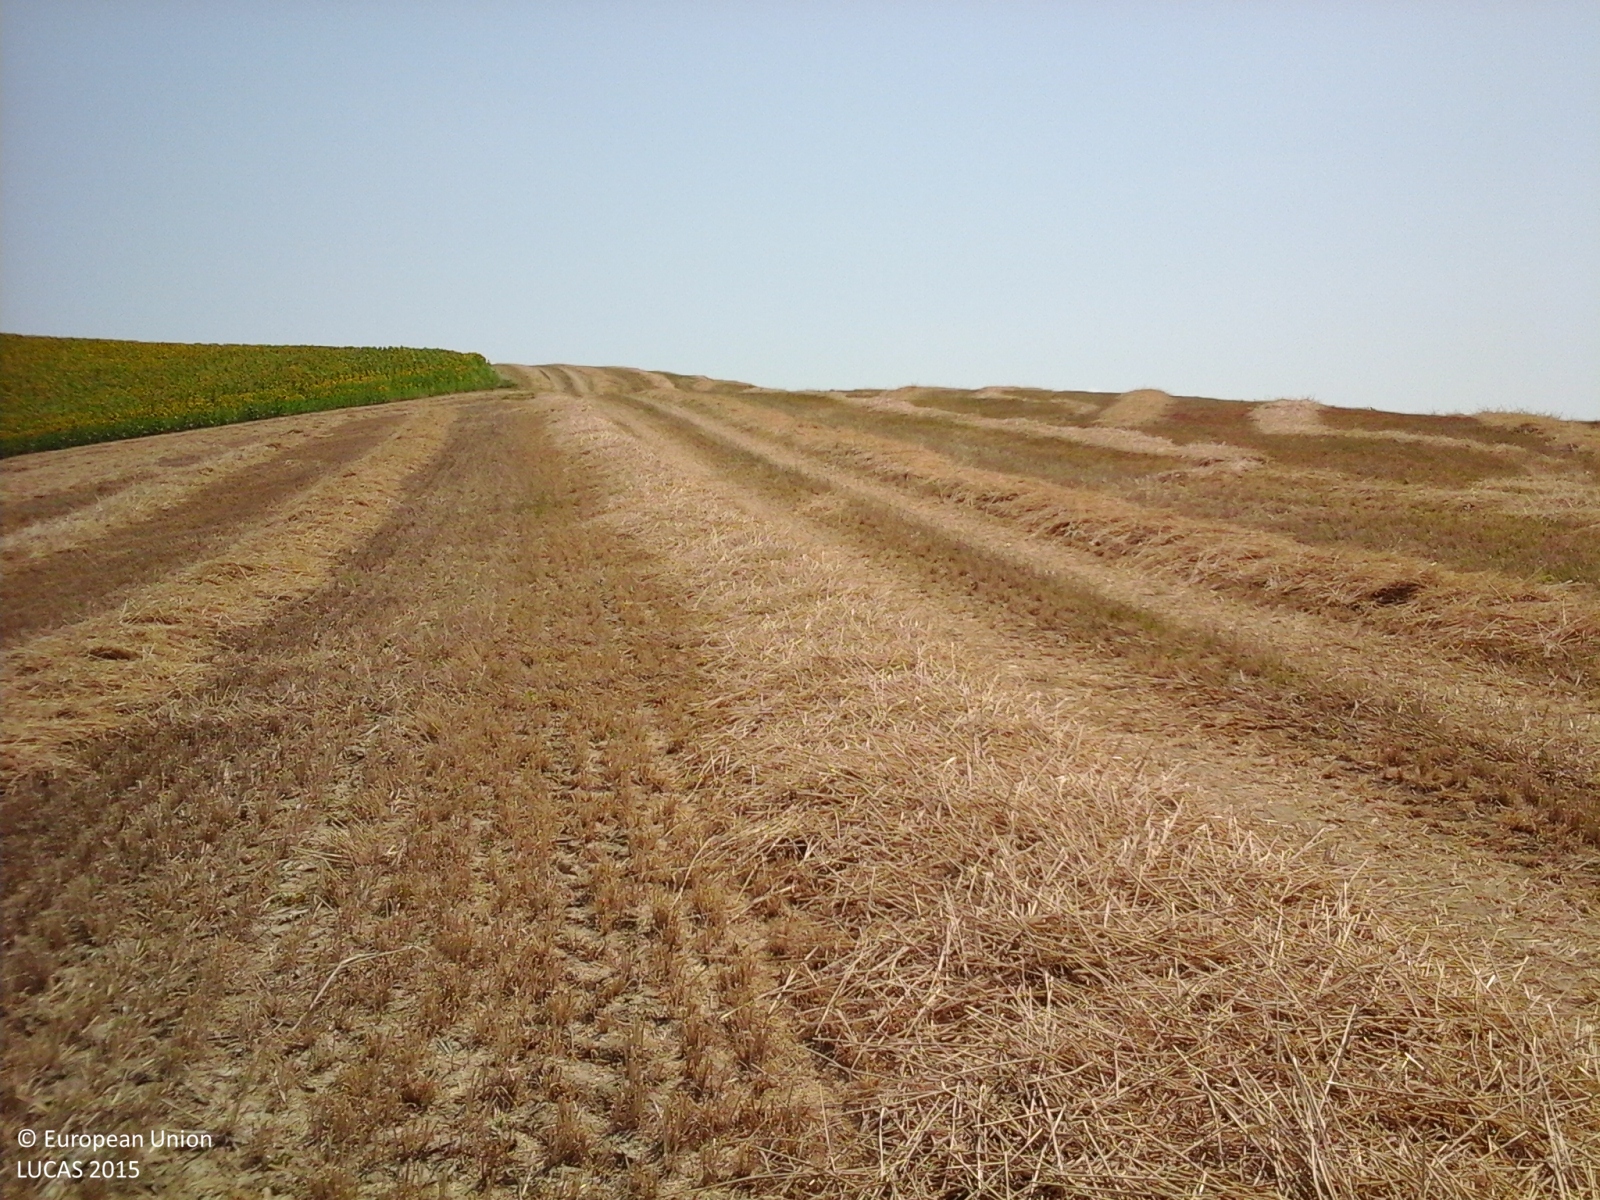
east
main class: Cropland
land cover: Durum wheat
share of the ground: > 75 %
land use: Agriculture (excluding fallow land and kitchen gardens)
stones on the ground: < 10 %
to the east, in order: Durum wheat; Tracks; Spontaneously vegetated surfaces; Broadleaved woodland; Electric lines; Broadleaved woodland
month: July
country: IT
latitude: 43.0226
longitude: 13.6347
